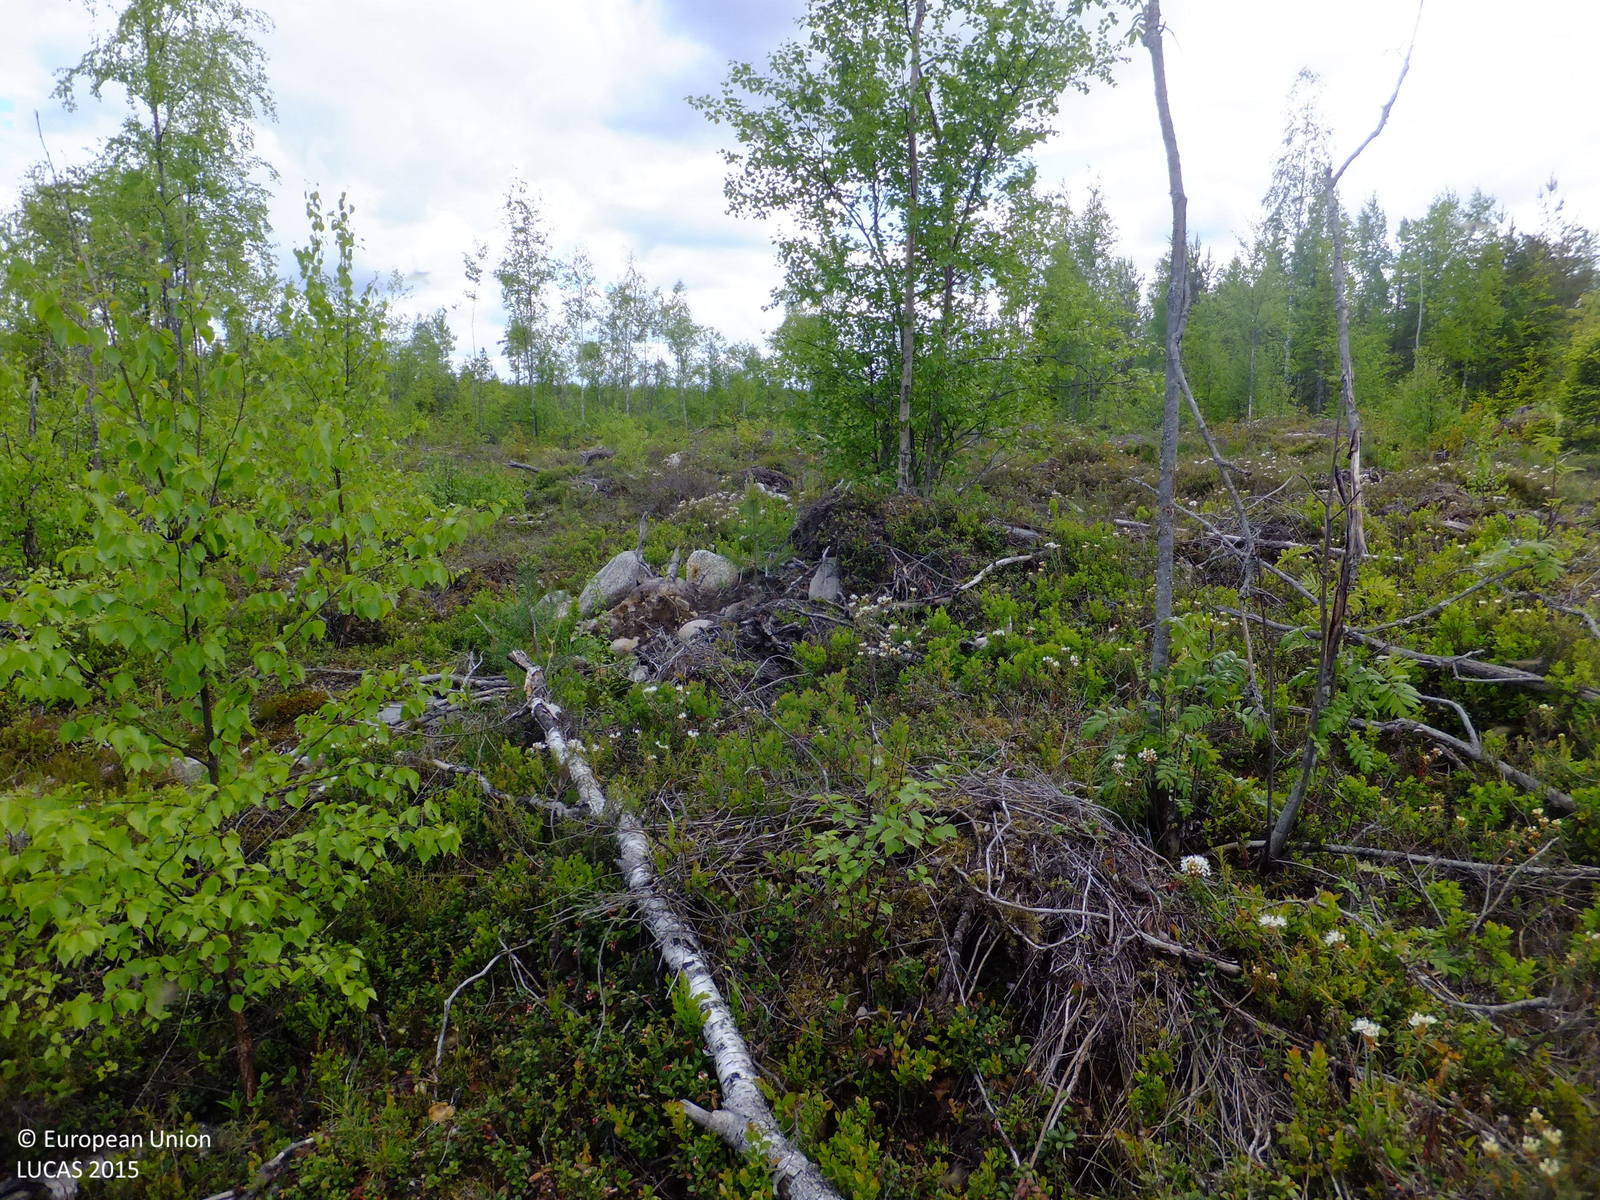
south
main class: Shrubland
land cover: Shrubland with sparse tree cover
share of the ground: > 75 %
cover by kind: shrubs 85 %, broadleaved forest trees 5 %, herbaceous plants 5 %, unconsolidated bare surface 5 %
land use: Forestry
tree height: > 5 m
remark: Clear cut
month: June
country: FI
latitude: 63.4739
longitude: 24.8381
